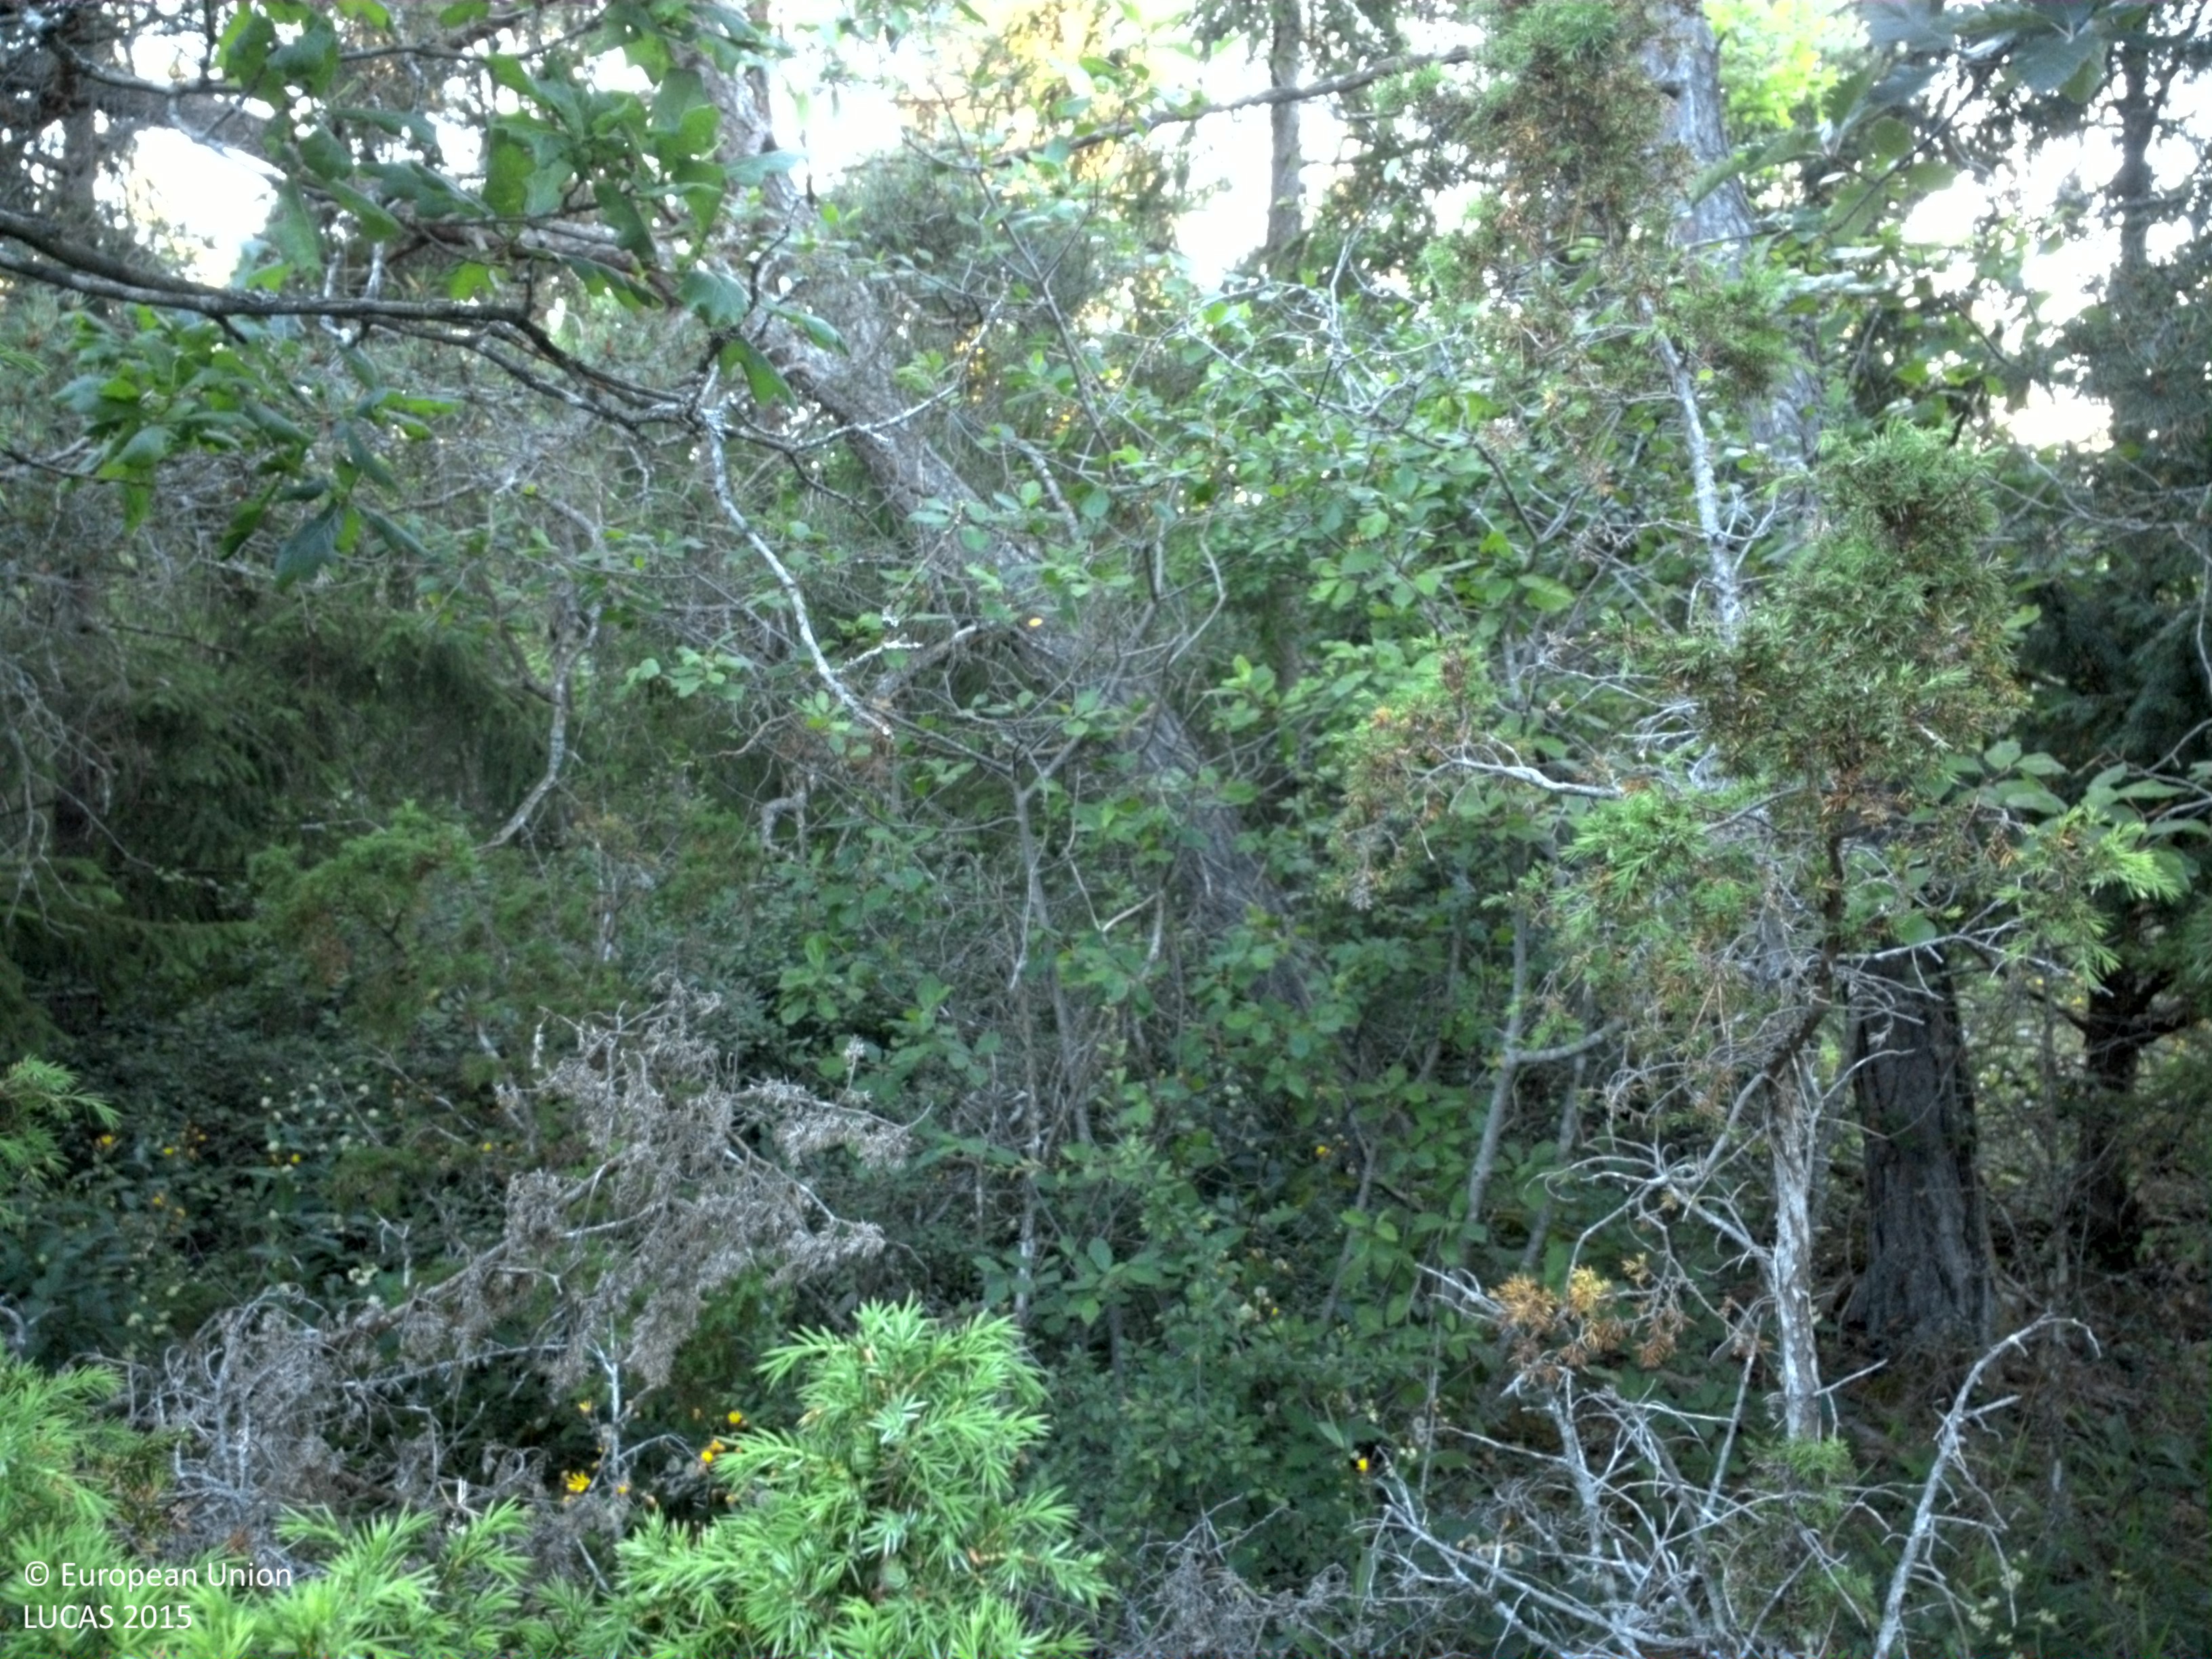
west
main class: Woodland
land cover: Pine dominated coniferous woodland
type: hemiboreal forest and nemoral coniferous forest and mixed broadleaved-coniferous forest
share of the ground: > 75 %
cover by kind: coniferous forest trees 80 %, herbaceous plants 10 %, broadleaved forest trees 5 %, shrubs 5 %
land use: Forestry
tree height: > 5 m
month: July
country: SE
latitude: 57.7497
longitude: 18.7972
